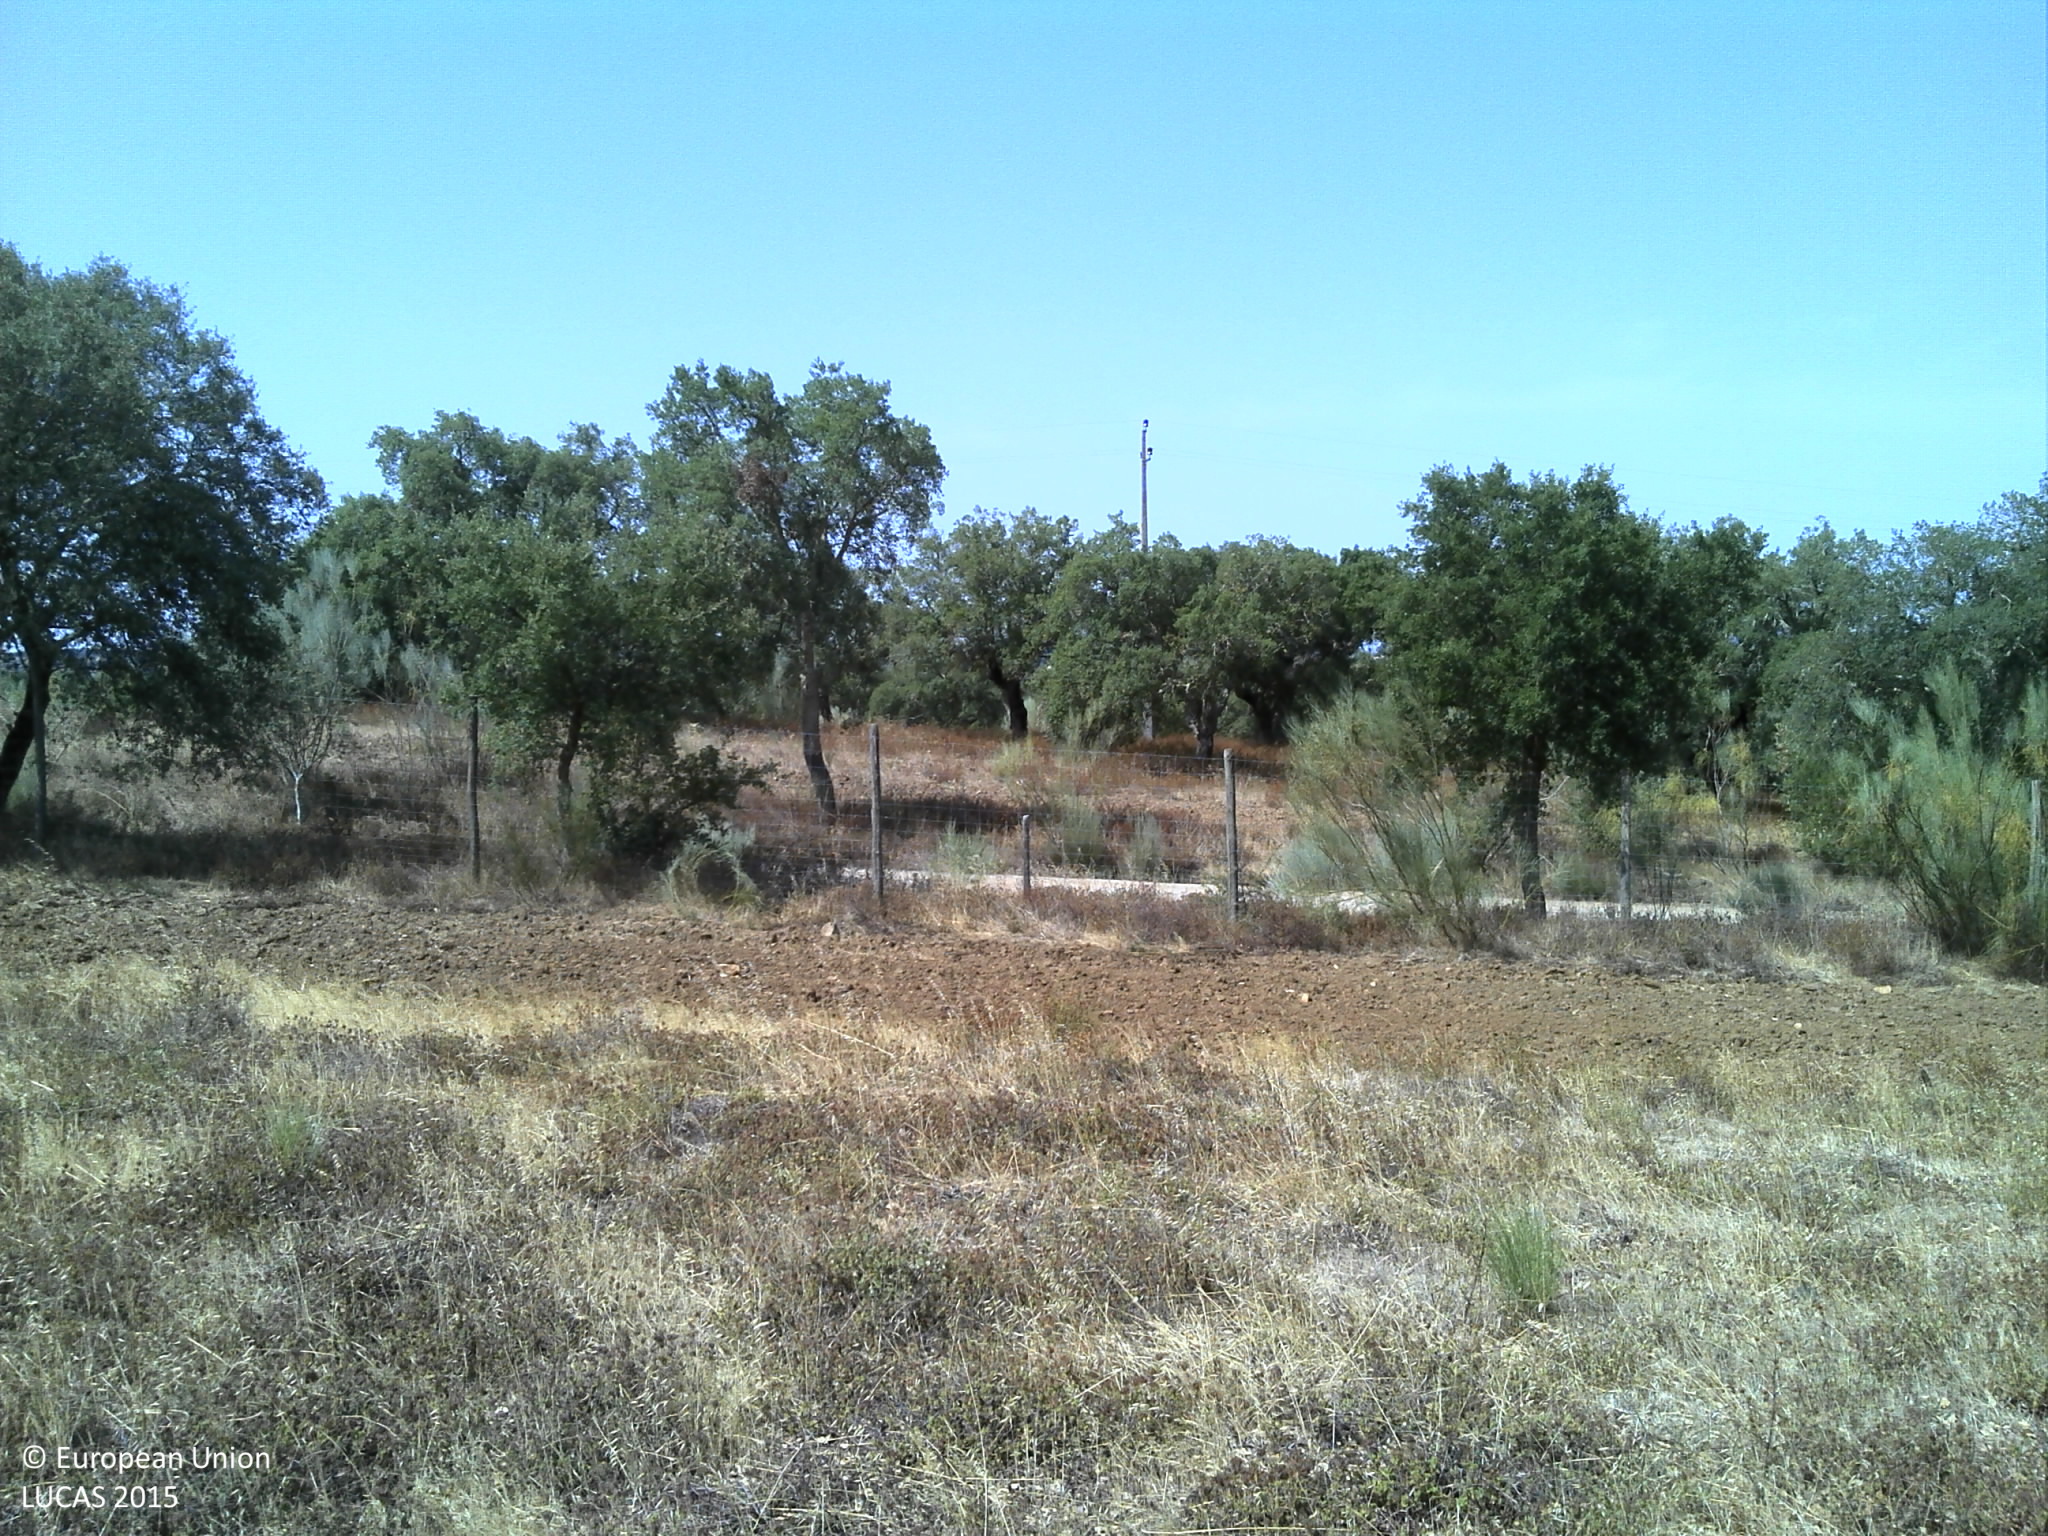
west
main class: Woodland
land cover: Broadleaved woodland
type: broadleaved evergreen forest
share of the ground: 10 - 25 %
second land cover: Grassland without tree/shrub cover
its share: 10 - 25 %
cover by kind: unconsolidated bare surface 70 %, broadleaved forest trees 15 %, herbaceous plants 15 %
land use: Forestry
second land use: Agriculture (excluding fallow land and kitchen gardens)
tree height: > 5 m
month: July
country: PT
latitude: 38.7247
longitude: -7.8582
